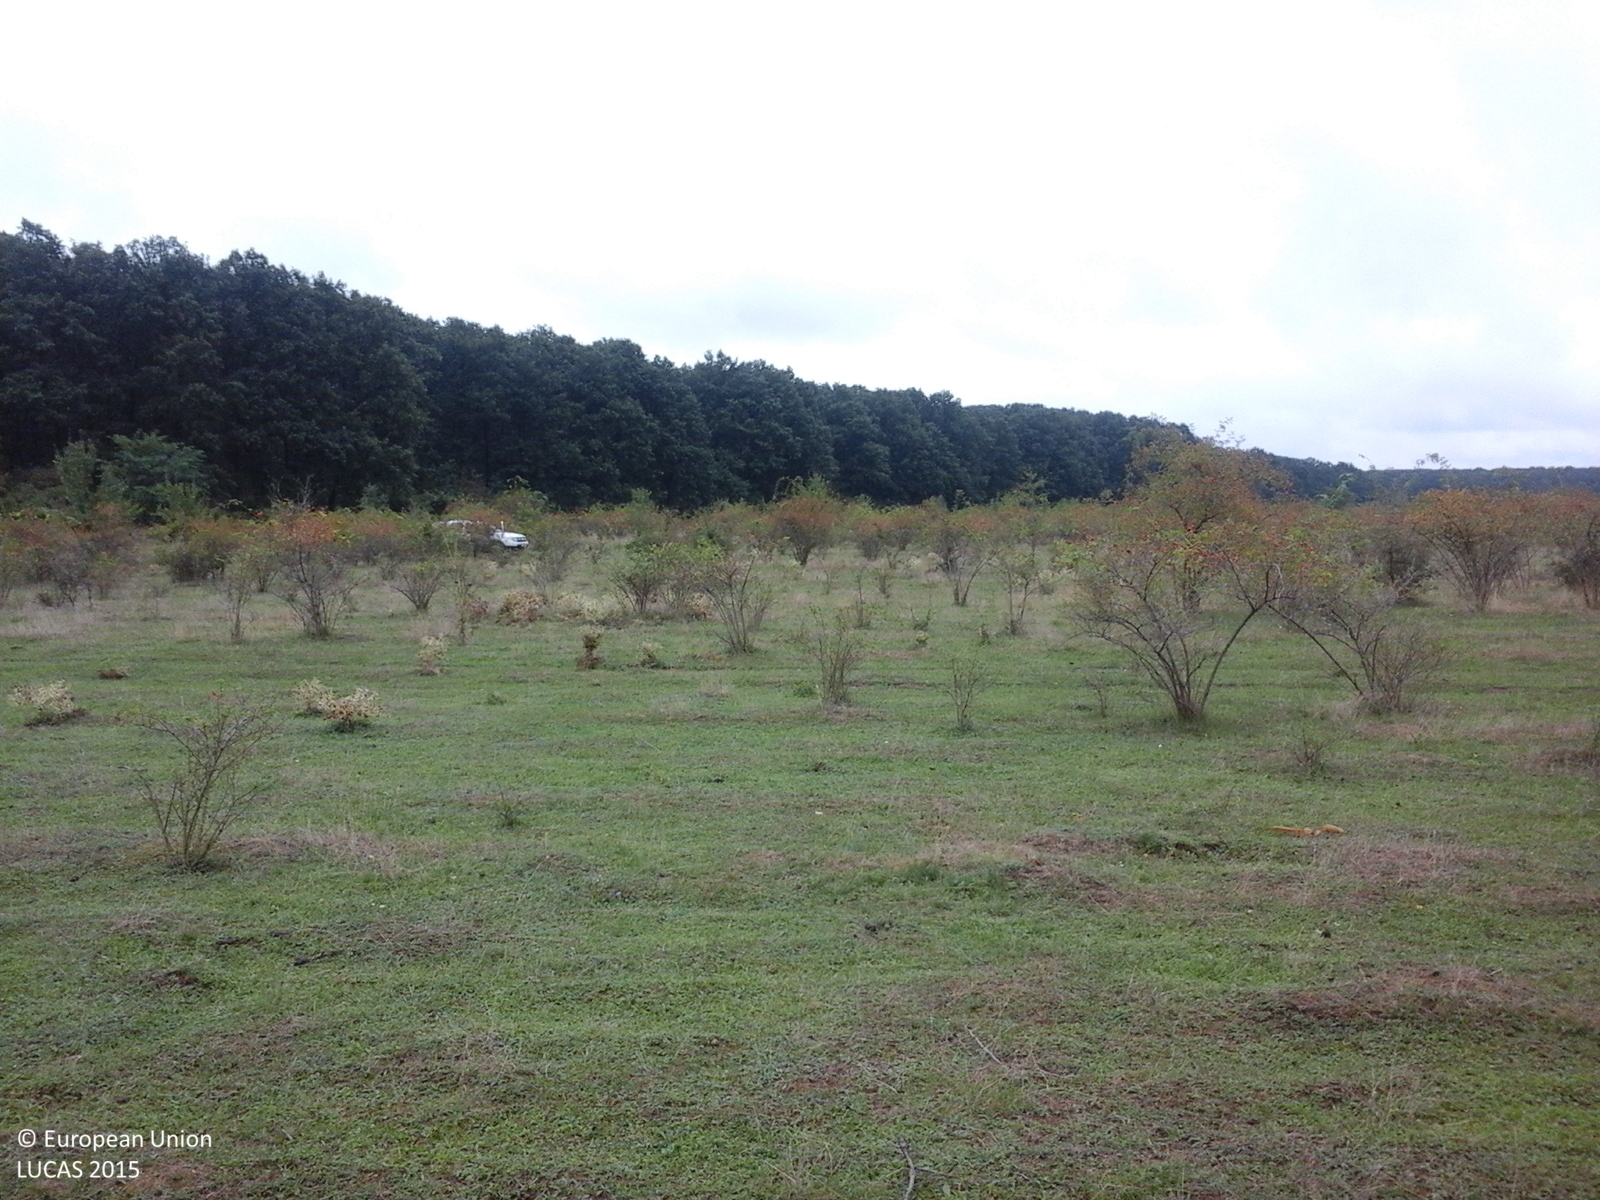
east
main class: Artificial land
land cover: Non built-up area features
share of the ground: 50 - 75 %
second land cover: Grassland without tree/shrub cover
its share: > 75 %
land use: Energy production
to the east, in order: Artificial constructions in urban areas; Grassland without tree/shrub cover; Grassland with sparse tree/shrub cover; Tracks; Grassland with sparse tree/shrub cover
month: September
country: RO
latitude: 46.9298
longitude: 21.8254
